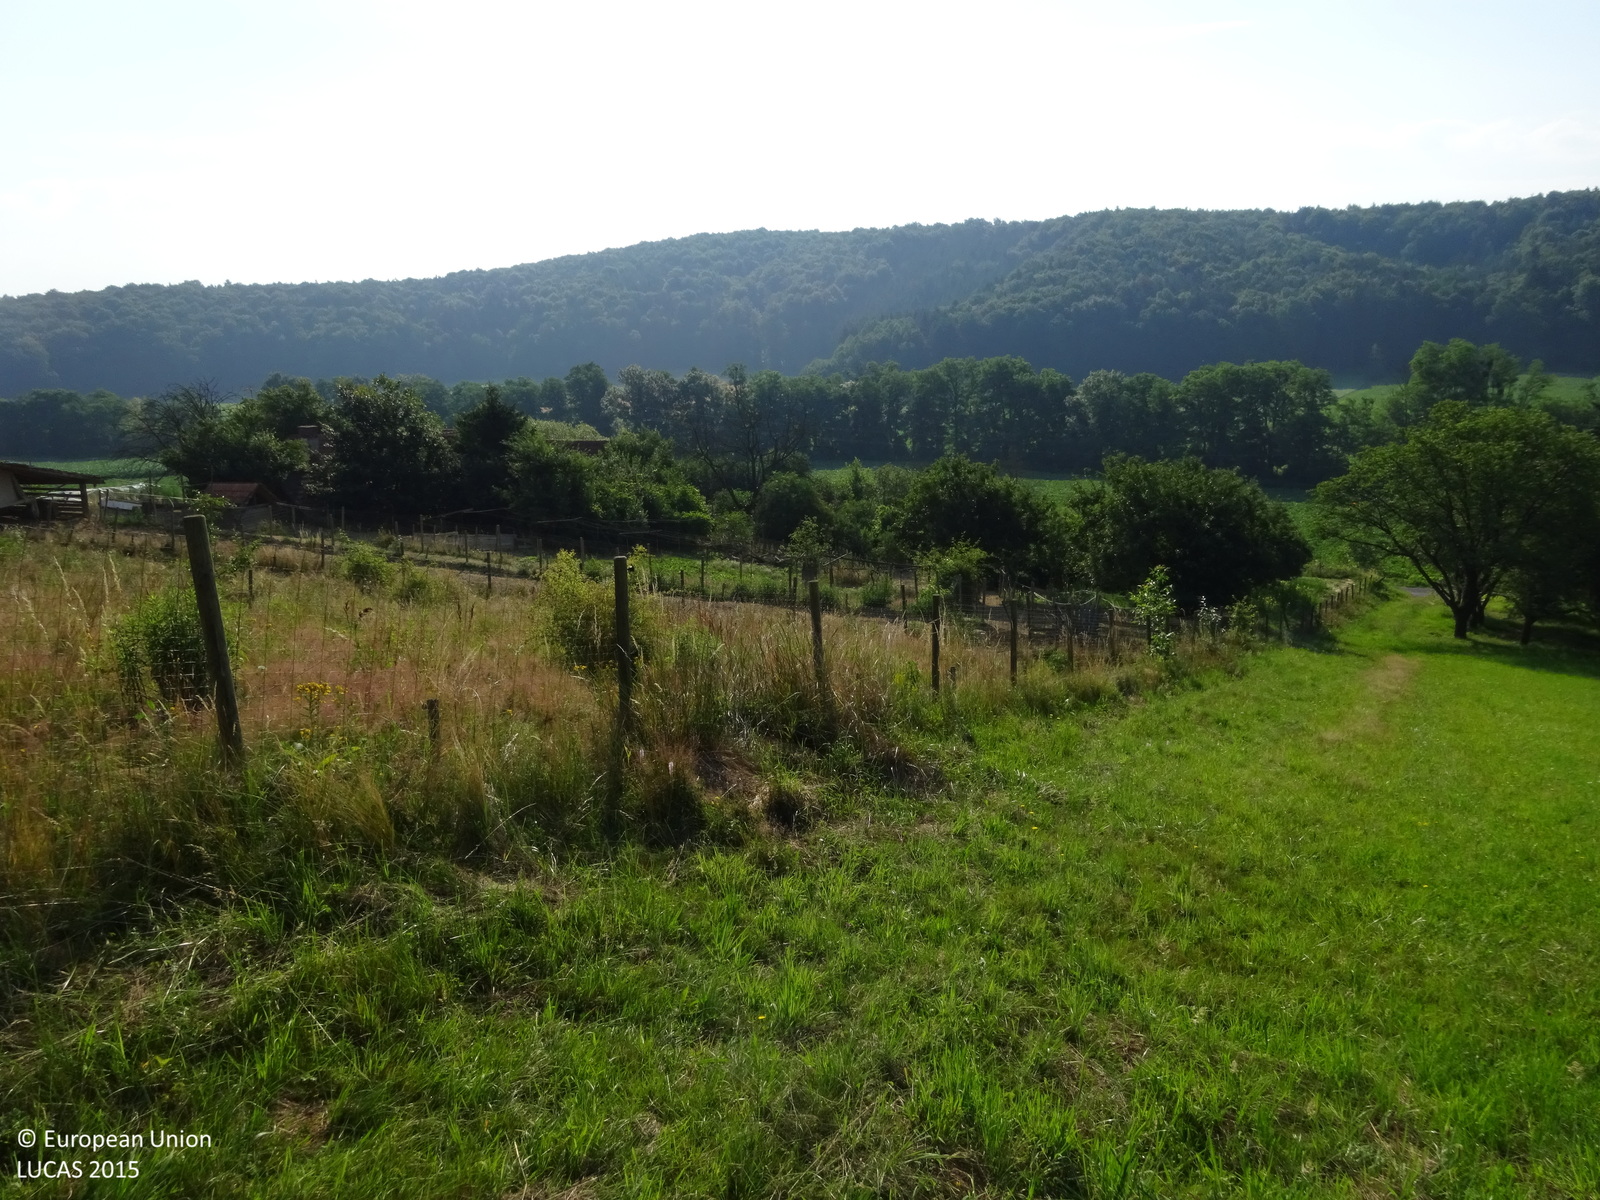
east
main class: Cropland
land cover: Apple fruit
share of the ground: 25 - 50 %
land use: Kitchen garden
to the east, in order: Apple fruit; Grassland without tree/shrub cover; Fences; Grassland with sparse tree/shrub cover; Fences; Grassland with sparse tree/shrub cover; Artificial constructions in urban areas; Grass margins; Grassland with sparse tree/shrub cover; Paved roads, cycling and walking lanes; Other fibre and oleaginous crops; Electric lines; Other fibre and oleaginous crops; Electric lines; Other fibre and oleaginous crops; Broadleaved woodland; Rivers and streams
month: July
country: AT
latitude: 46.9215
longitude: 16.0285
